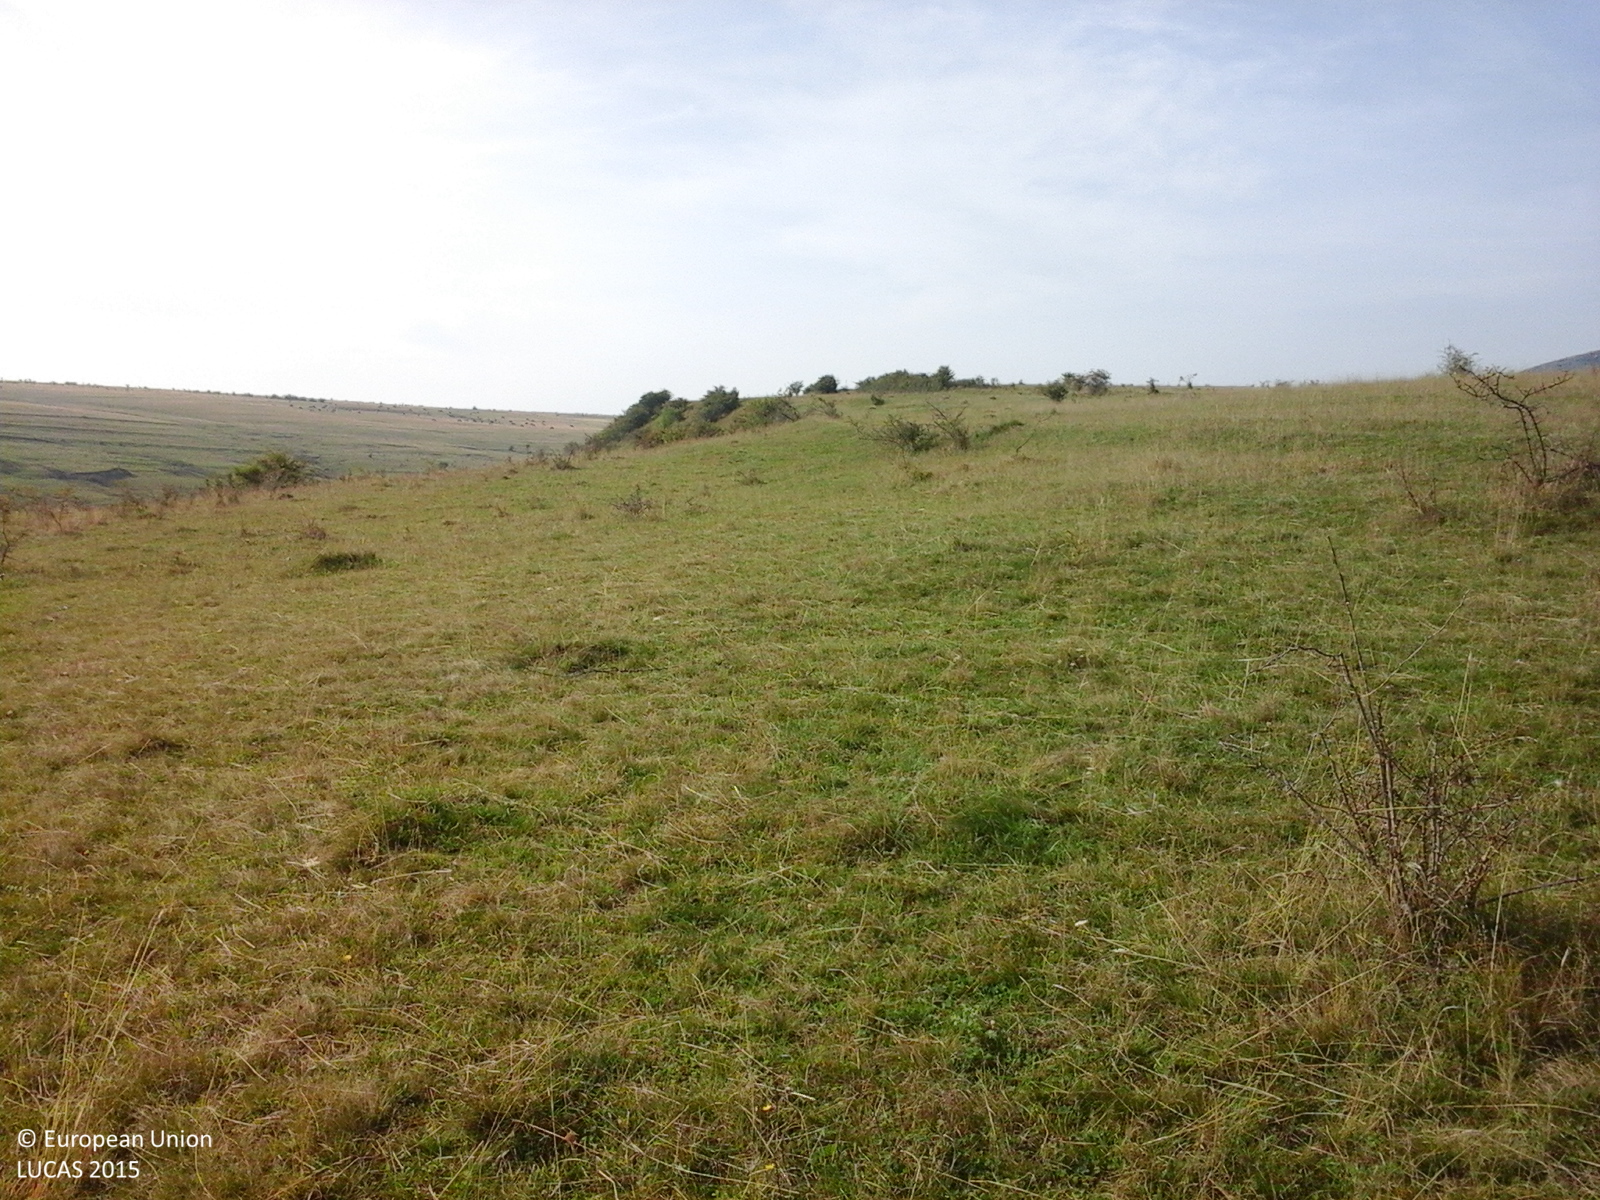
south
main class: Grassland
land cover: Grassland with sparse tree/shrub cover
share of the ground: > 75 %
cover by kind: herbaceous plants 90 %, broadleaved forest trees 5 %, shrubs 5 %
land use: Agriculture (excluding fallow land and kitchen gardens)
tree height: < 5 m
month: September
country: RO
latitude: 46.8155
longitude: 22.9702
